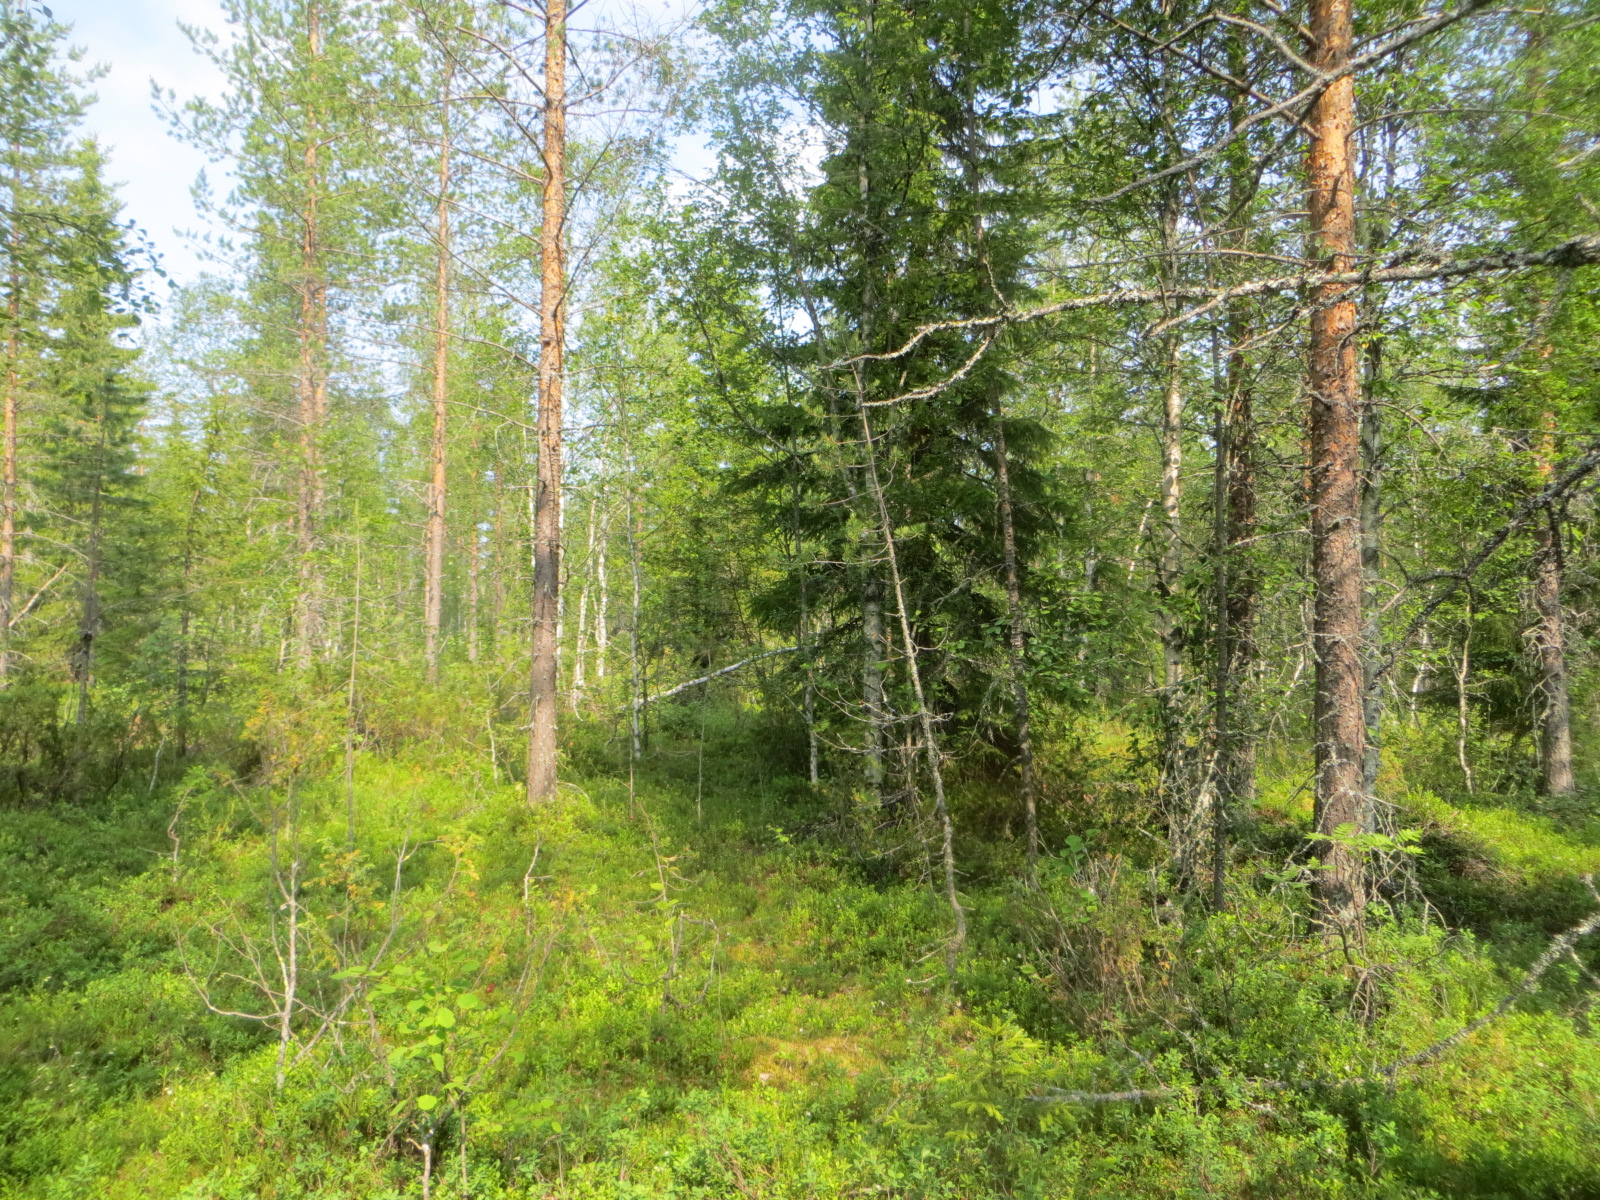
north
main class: Woodland
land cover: Other mixed woodland
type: boreal forest
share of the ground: 50 - 75 %
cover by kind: coniferous forest trees 40 %, broadleaved forest trees 30 %, shrubs 30 %
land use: Forestry
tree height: > 5 m
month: July
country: FI
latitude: 65.8839
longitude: 25.5364
